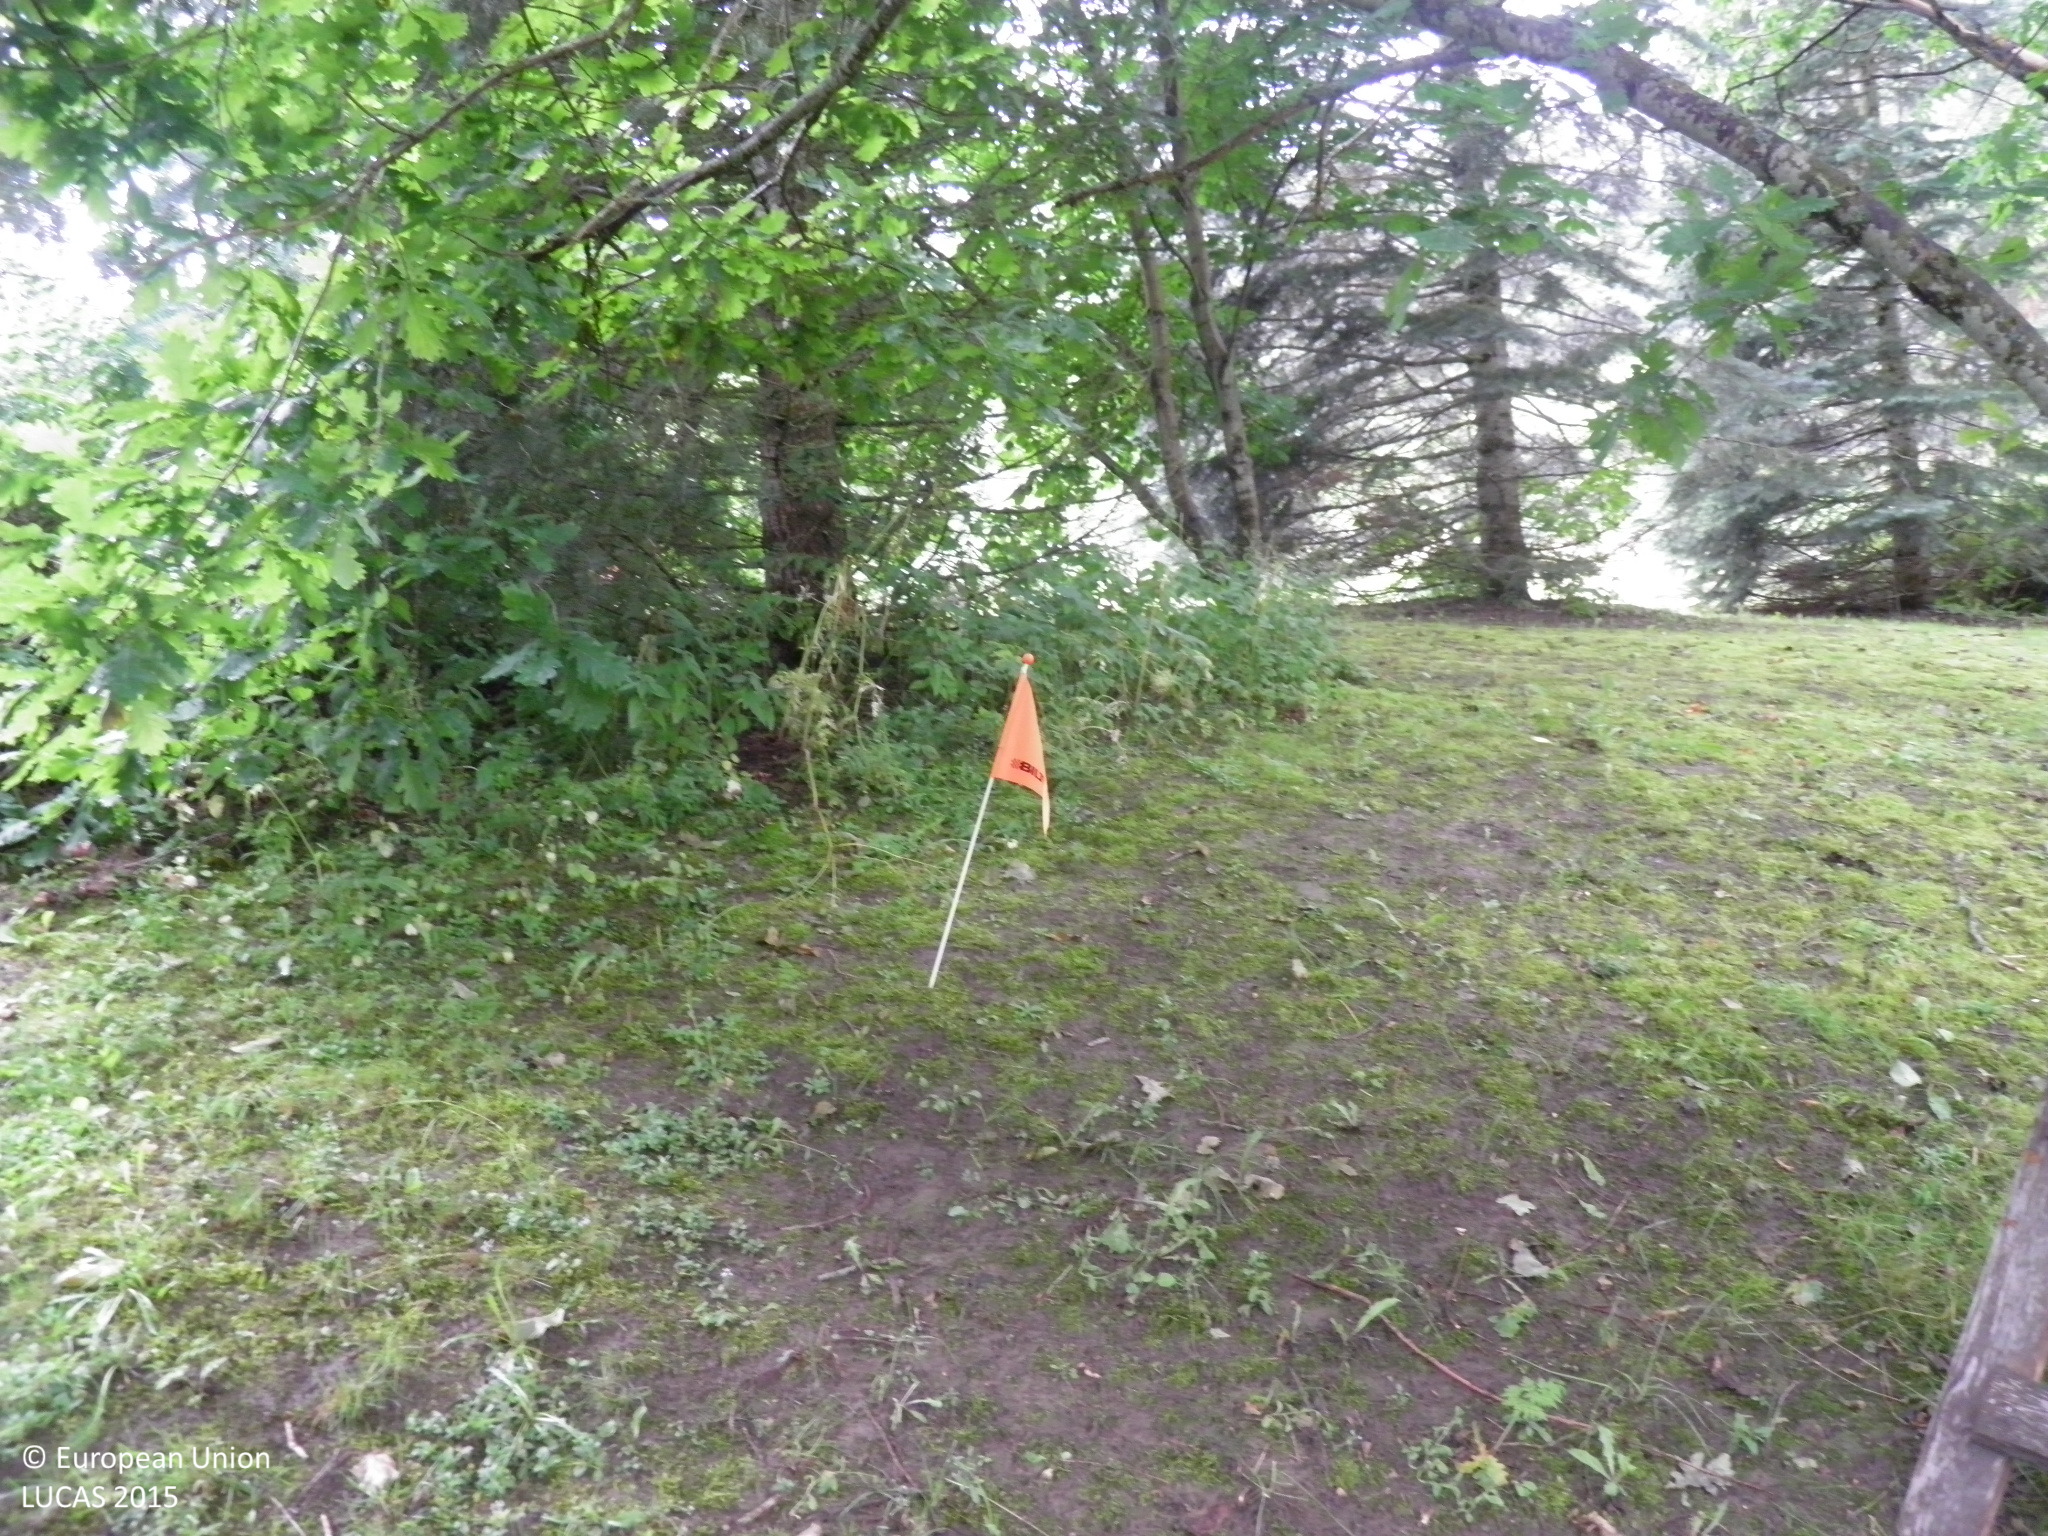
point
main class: Woodland
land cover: Spruce dominated mixed woodland
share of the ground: > 75 %
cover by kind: broadleaved forest trees 50 %, coniferous forest trees 25 %, herbaceous plants 15 %, shrubs 10 %
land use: Residential
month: July
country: FI
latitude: 60.1643
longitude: 22.5608
